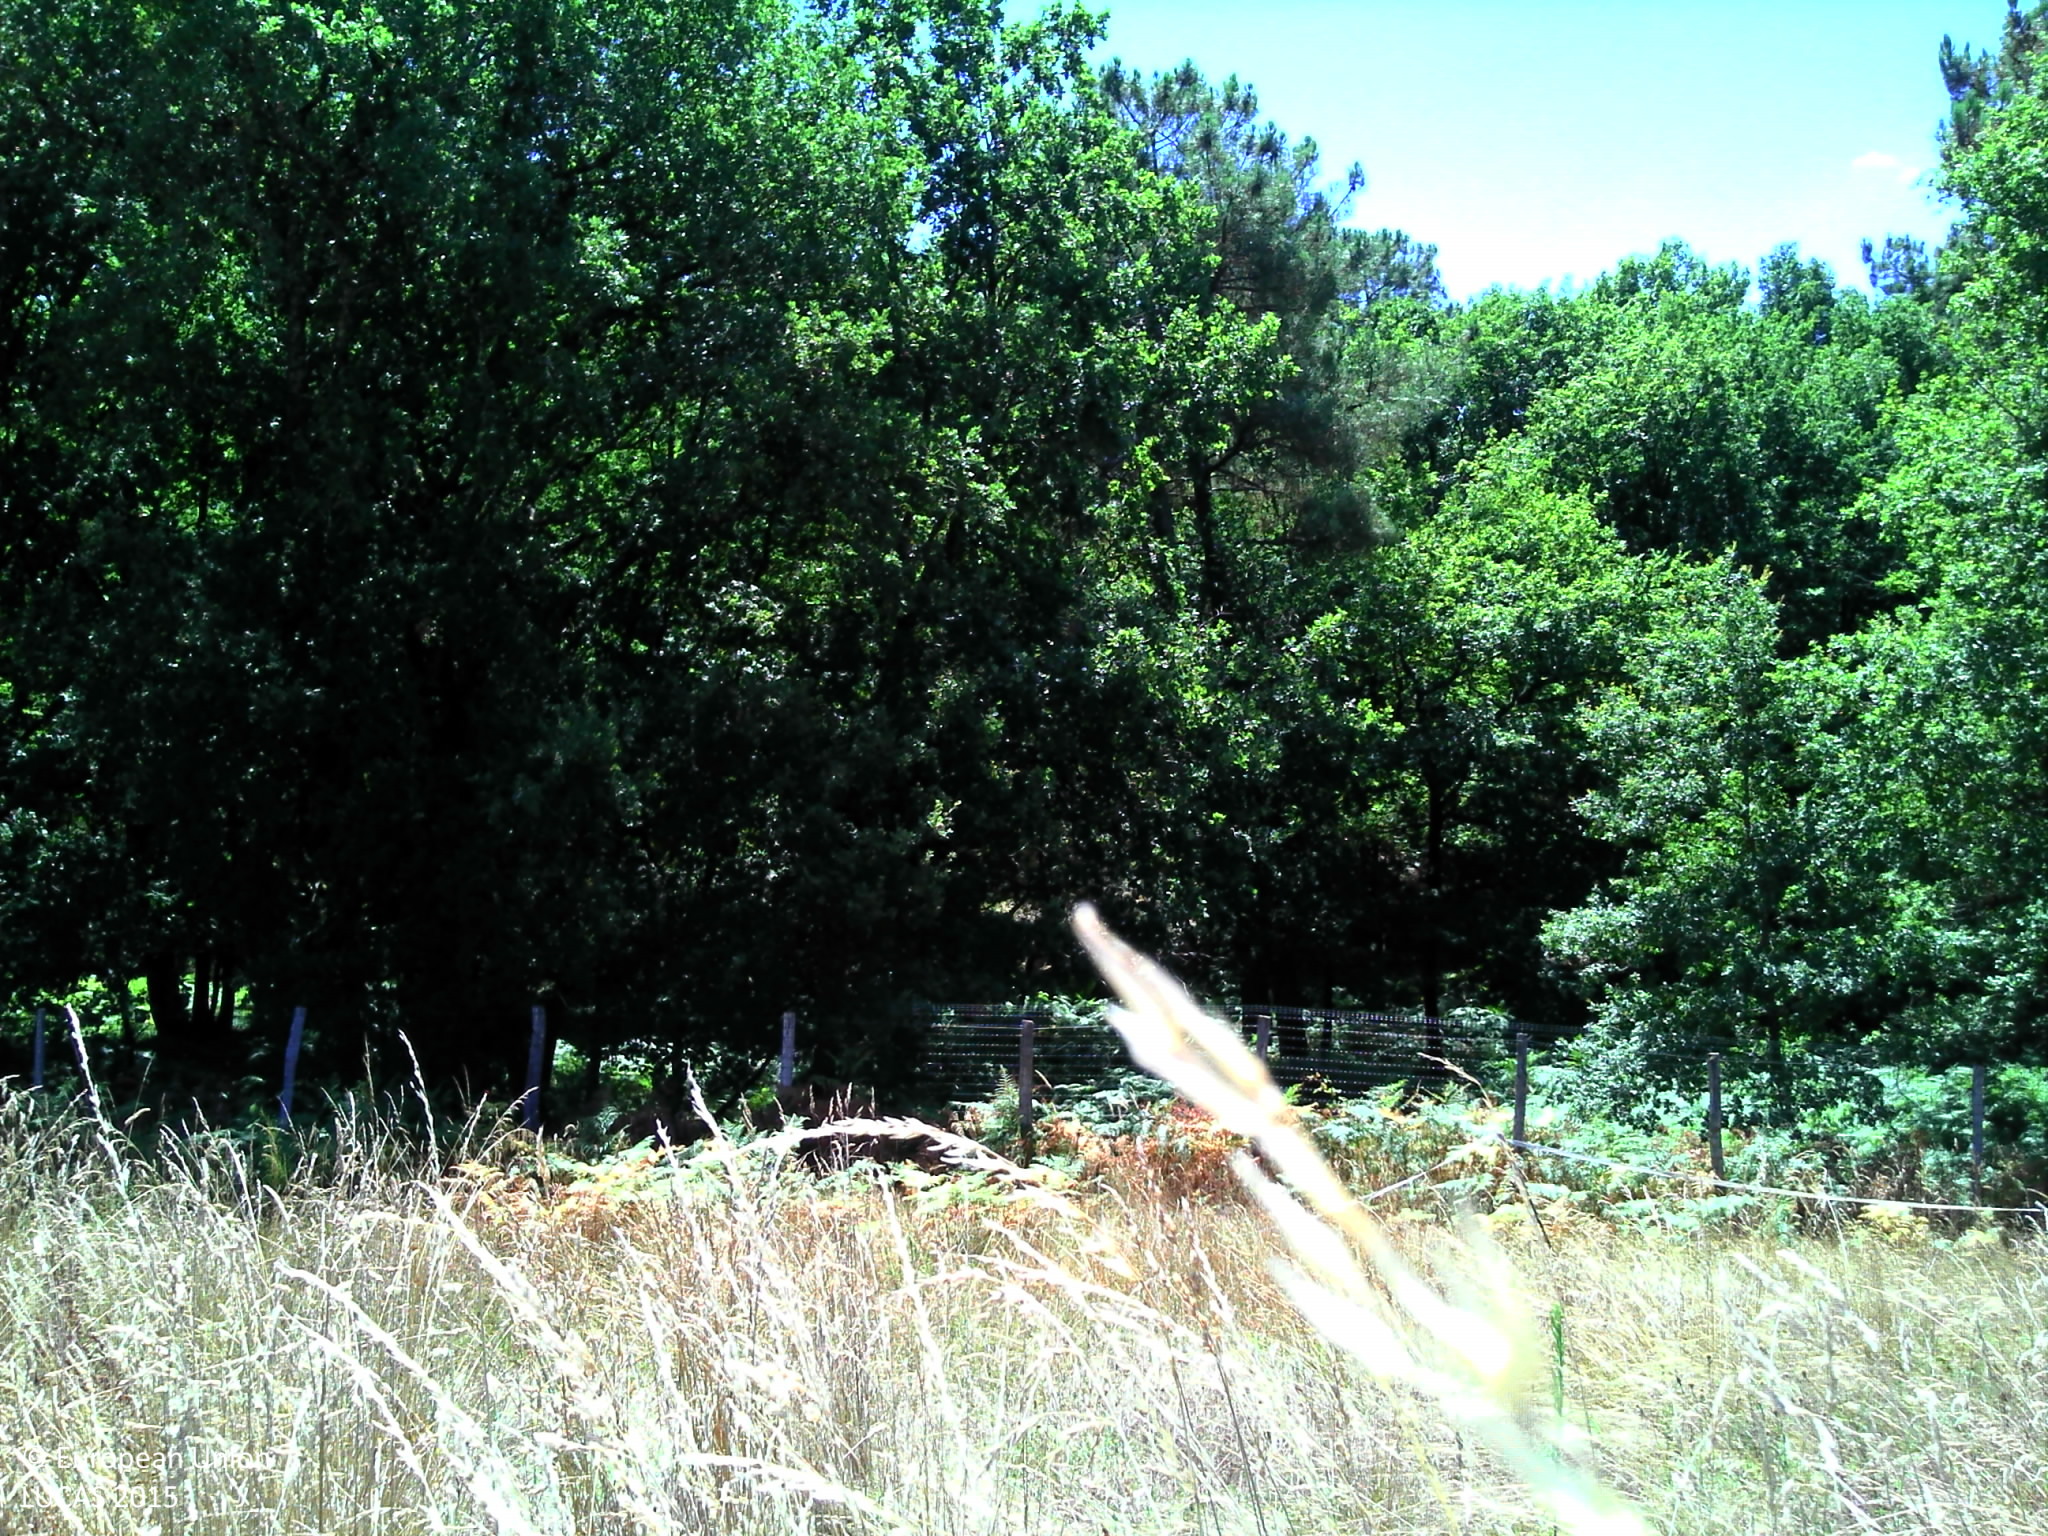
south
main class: Grassland
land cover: Grassland with sparse tree/shrub cover
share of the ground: > 75 %
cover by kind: herbaceous plants 95 %, broadleaved forest trees 5 %
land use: Agriculture (excluding fallow land and kitchen gardens)
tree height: < 5 m
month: July
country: FR
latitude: 44.8095
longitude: 0.5712
